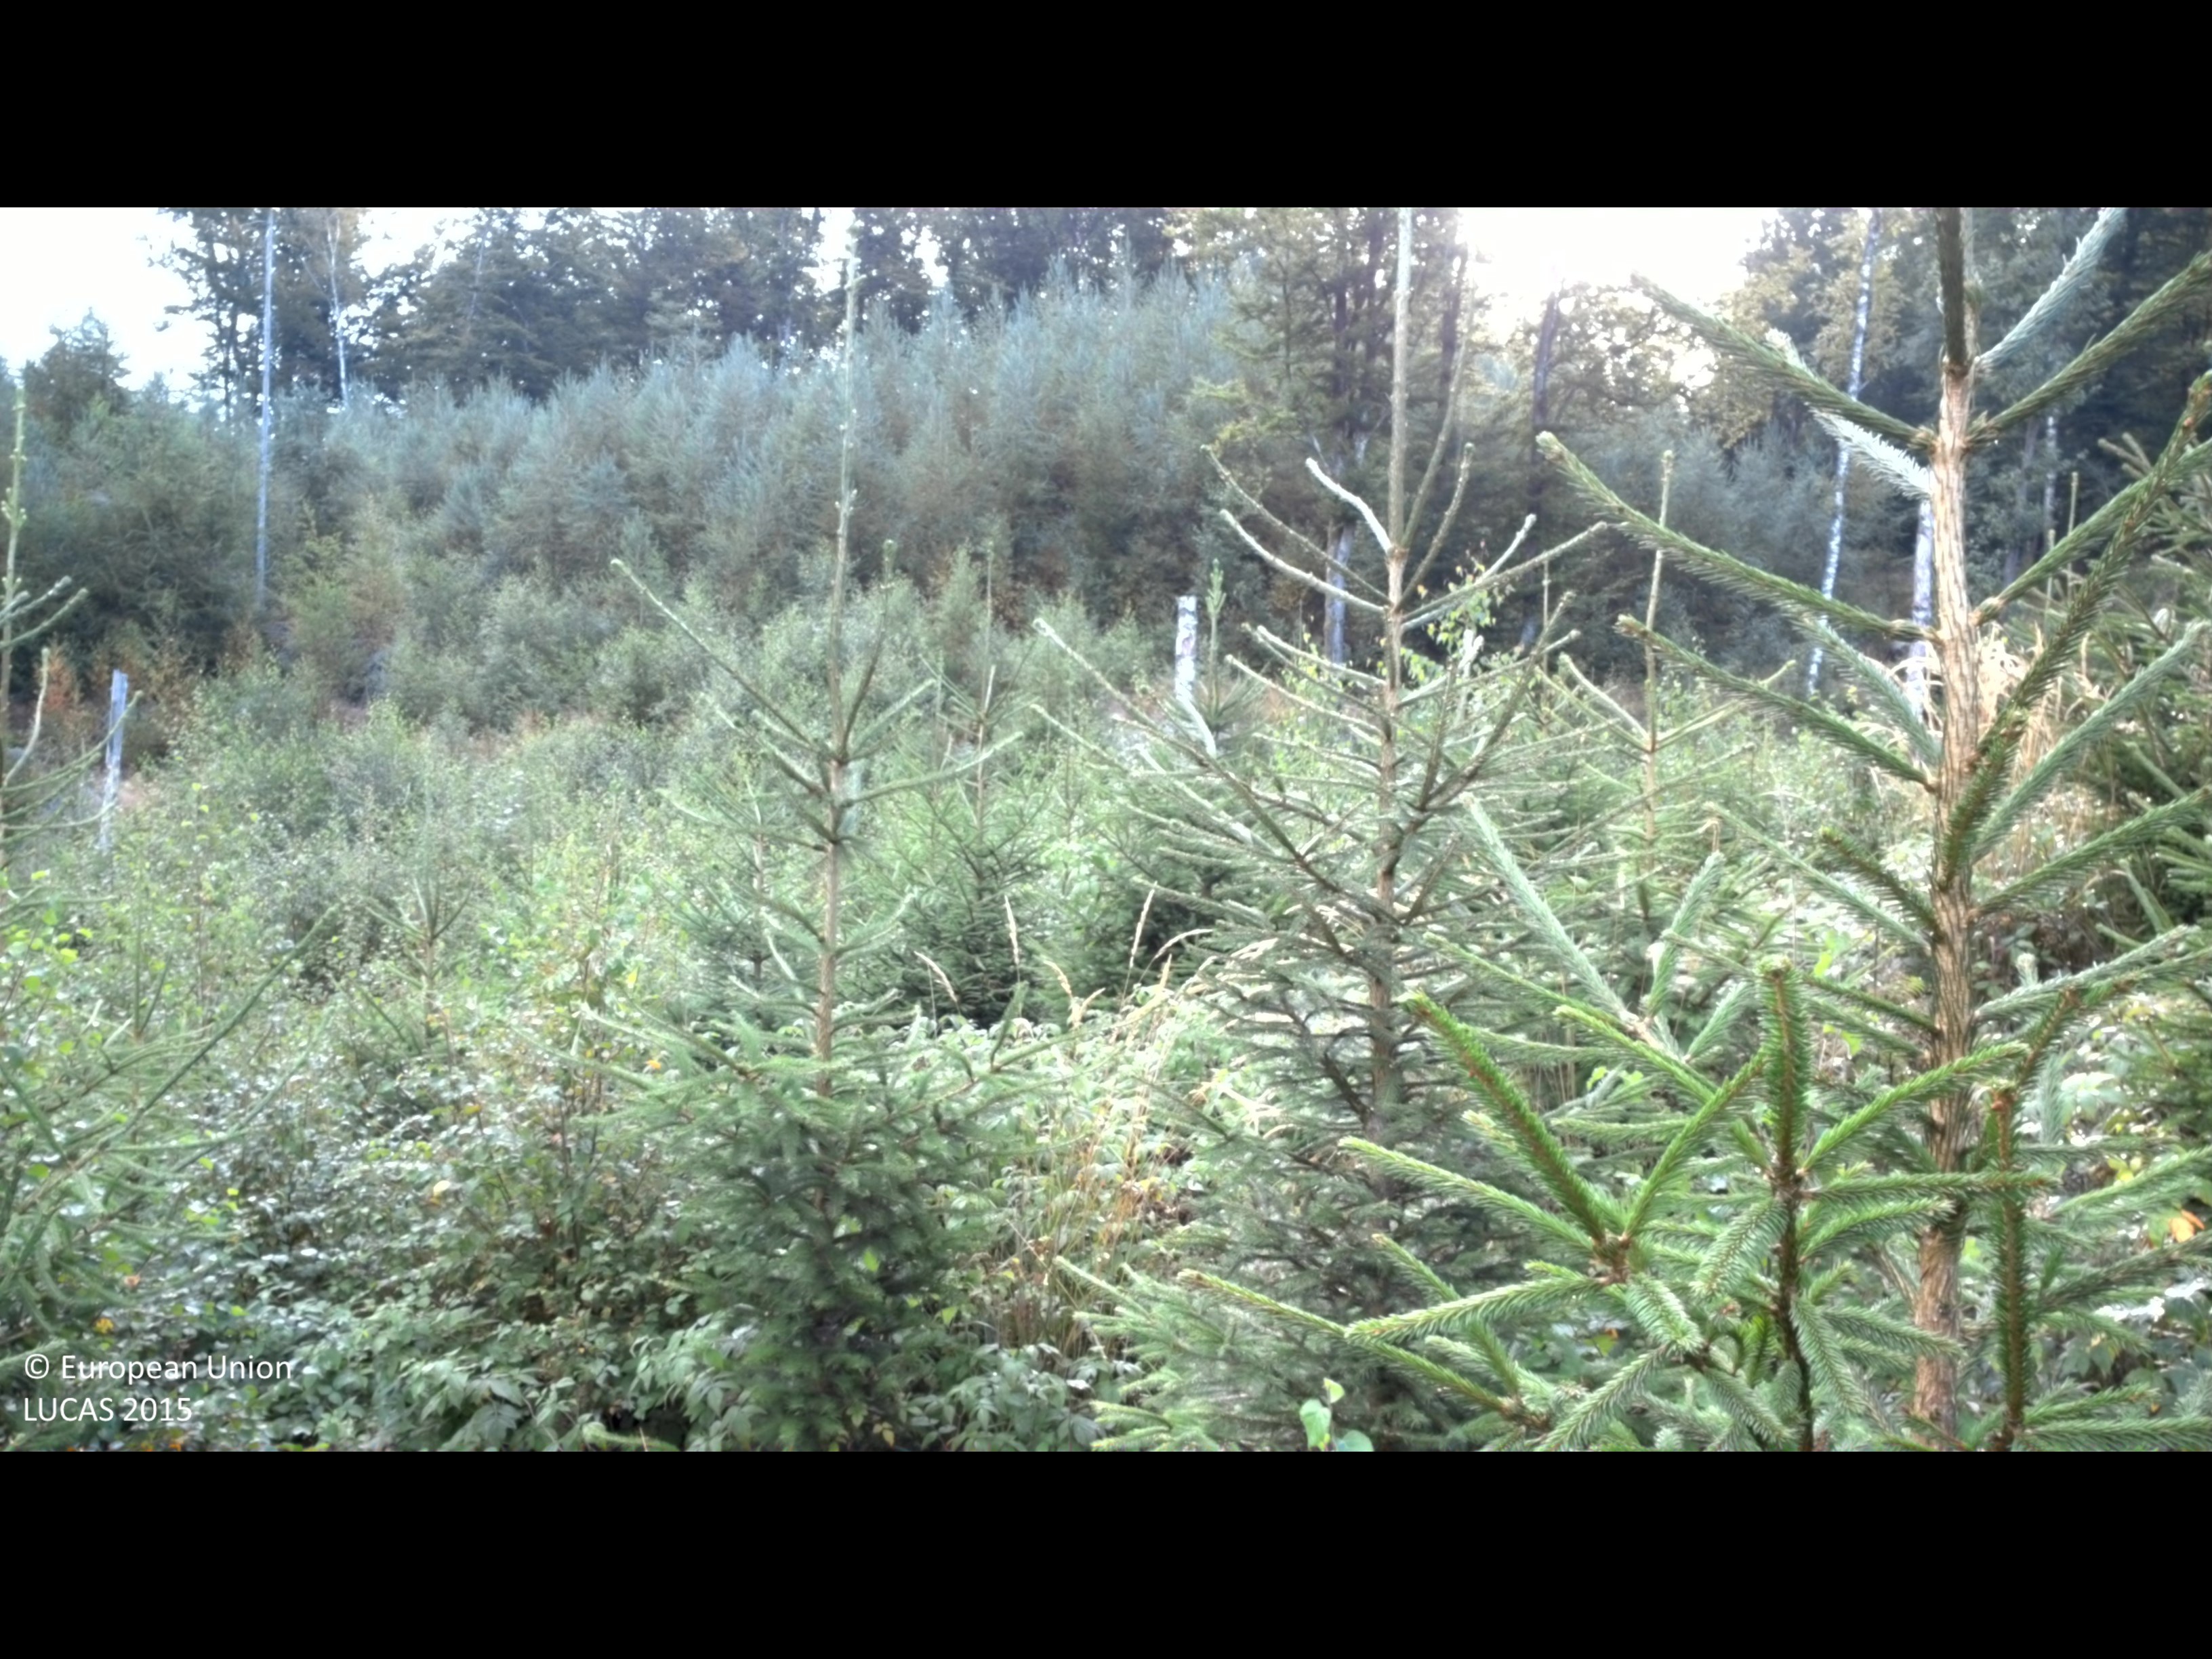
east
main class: Woodland
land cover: Spruce dominated mixed woodland
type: boreal forest
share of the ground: 50 - 75 %
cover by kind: coniferous forest trees 45 %, shrubs 30 %, broadleaved forest trees 15 %, herbaceous plants 10 %
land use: Forestry
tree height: < 5 m
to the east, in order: Spruce dominated mixed woodland; Tracks; Other mixed woodland; Other coniferous woodland; Broadleaved woodland; Other coniferous woodland; Broadleaved woodland; Other coniferous woodland; Spruce dominated mixed woodland
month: August
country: SE
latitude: 56.7951
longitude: 13.2221
